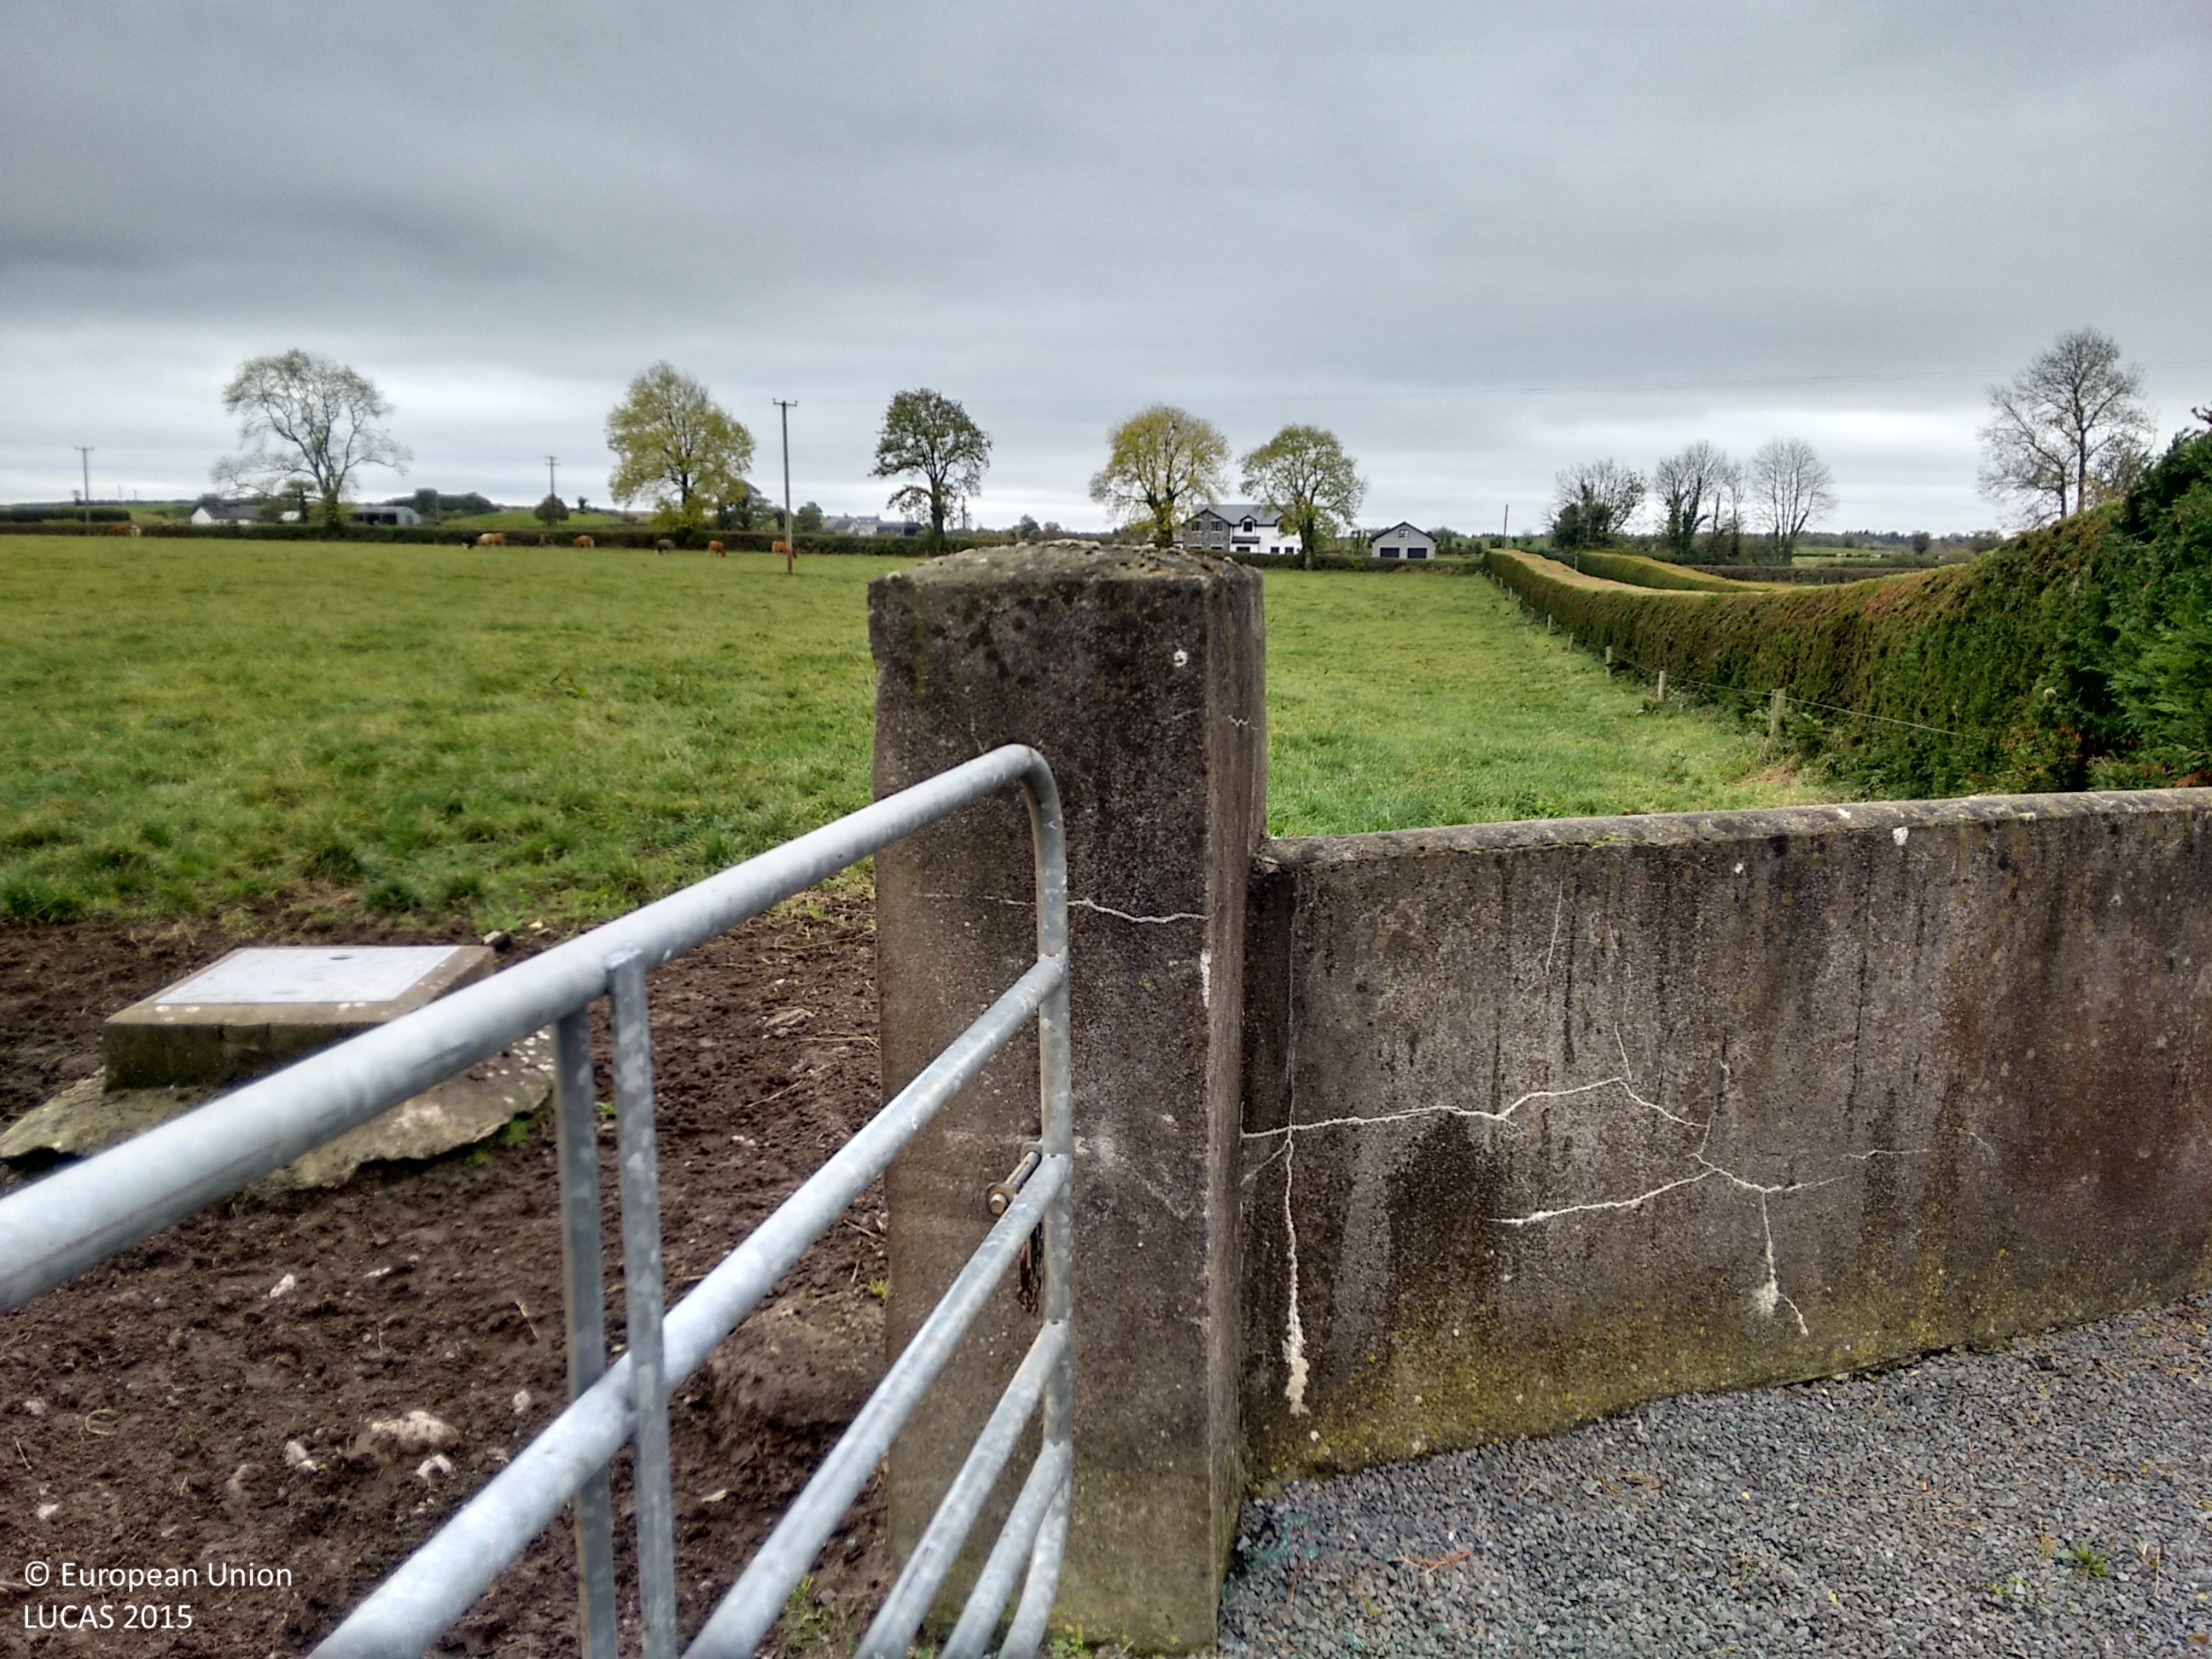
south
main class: Woodland
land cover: Broadleaved woodland
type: acidophilous oak and oak-birch forest
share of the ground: > 75 %
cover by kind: broadleaved forest trees 100 %
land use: Forestry
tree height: > 5 m
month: October
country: IE
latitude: 52.8343
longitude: -7.7265
